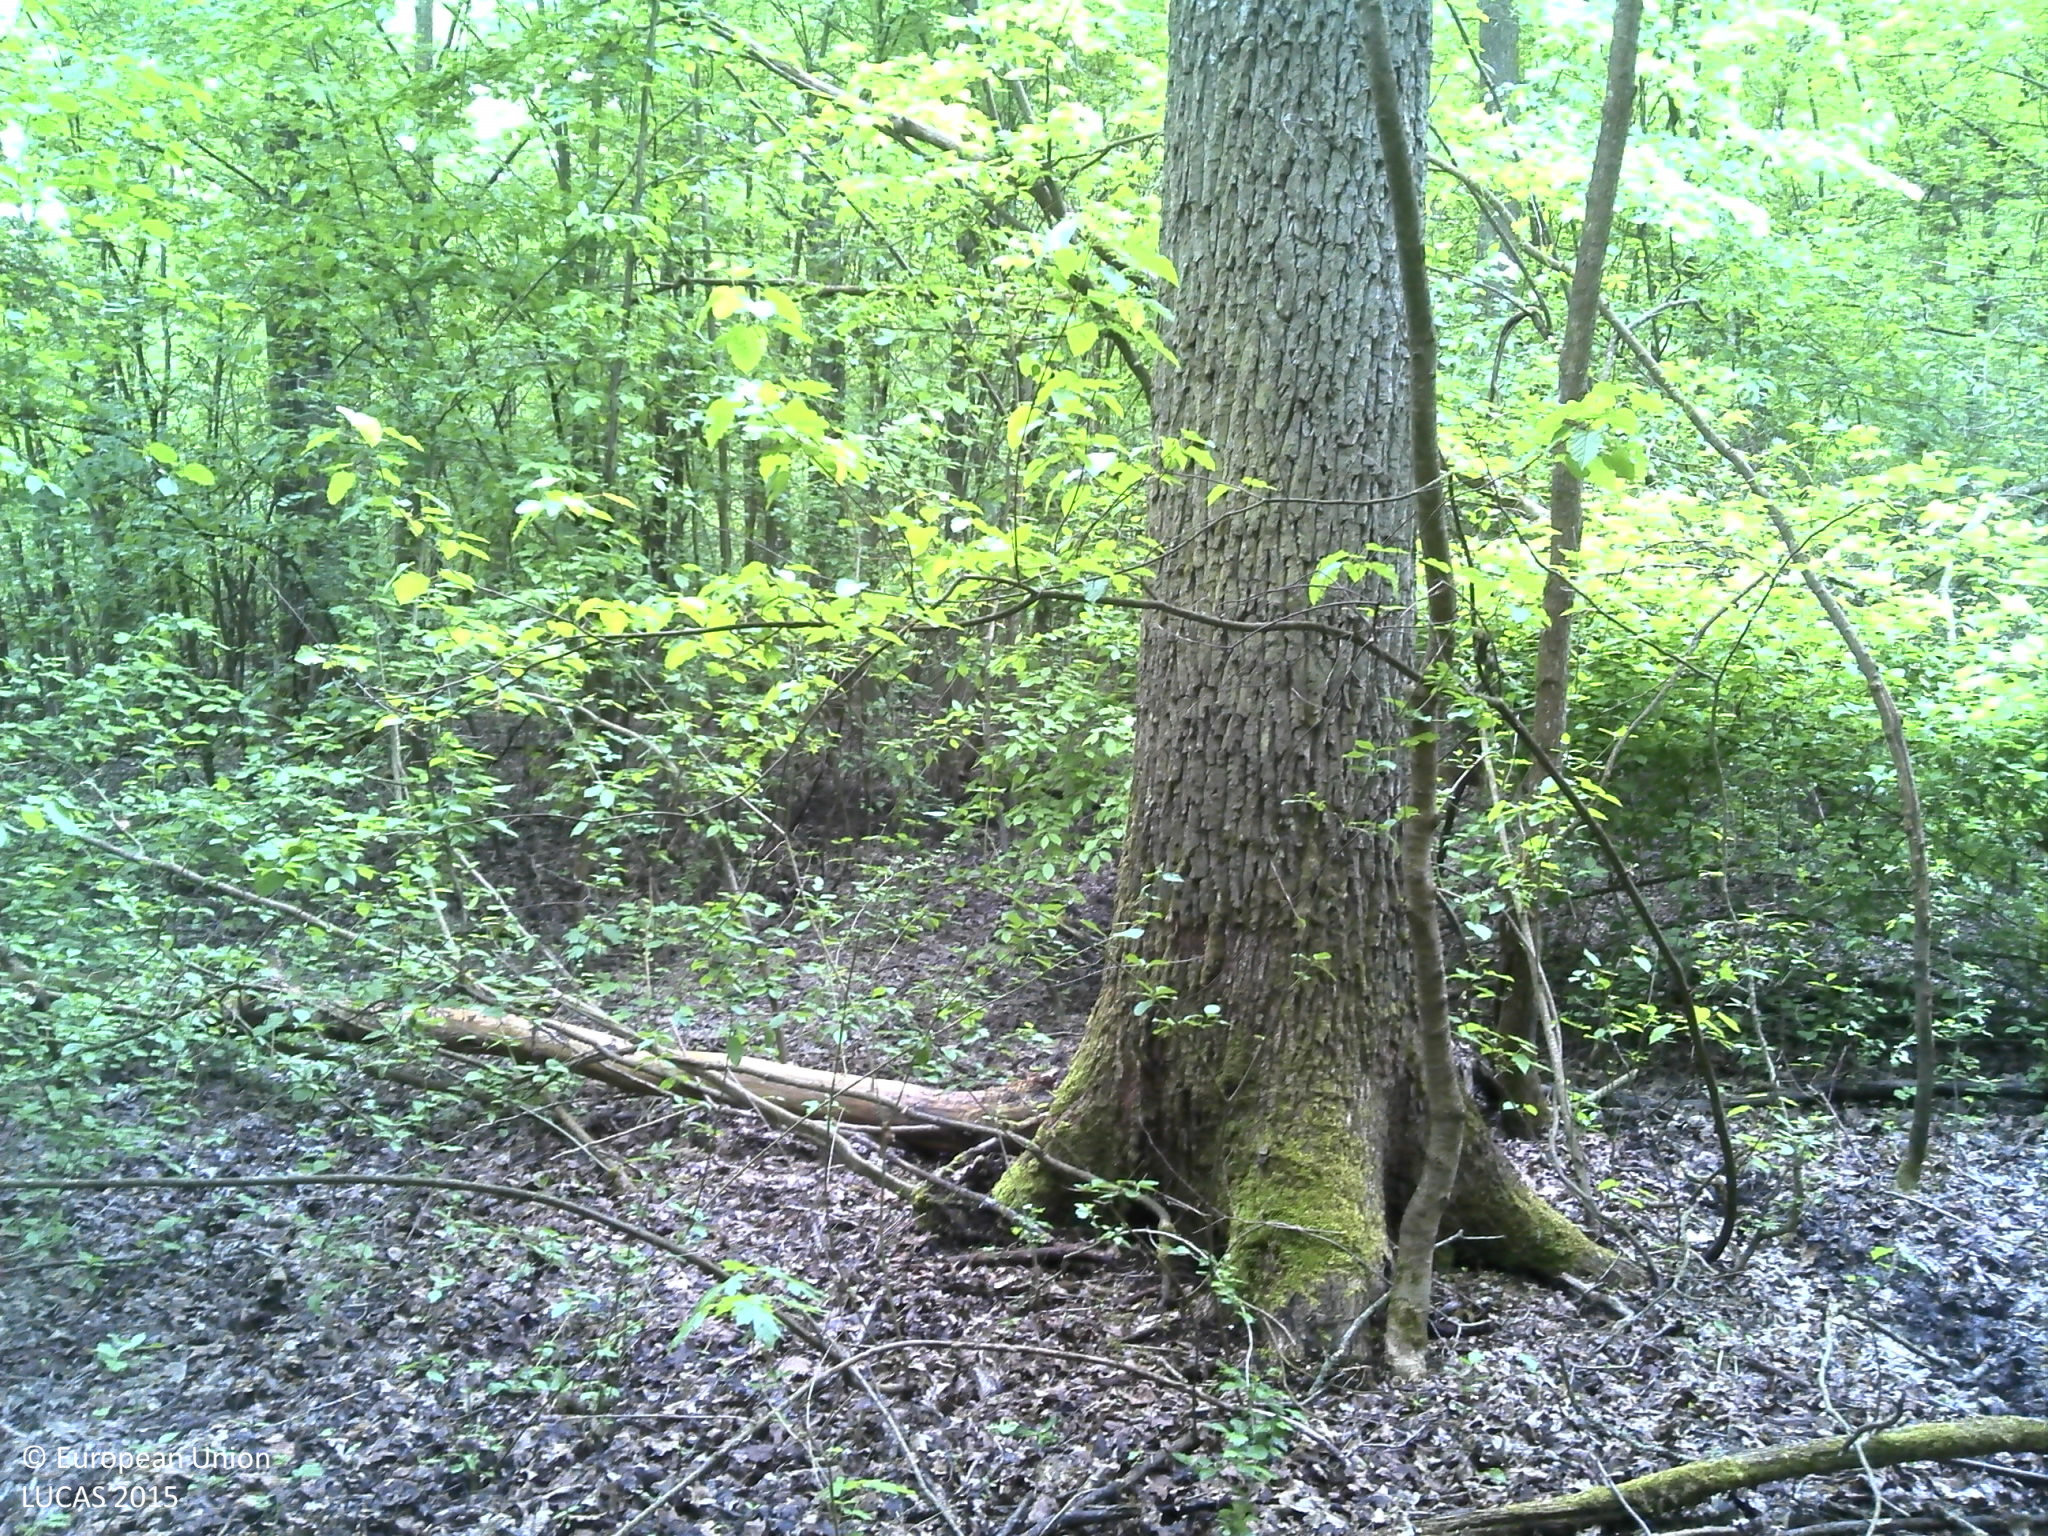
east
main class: Woodland
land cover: Broadleaved woodland
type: mesophytic deciduous forest
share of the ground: > 75 %
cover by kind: broadleaved forest trees 100 %
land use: Forestry
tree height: > 5 m
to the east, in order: Broadleaved woodland
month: April
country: HR
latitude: 45.0304
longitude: 18.9808
